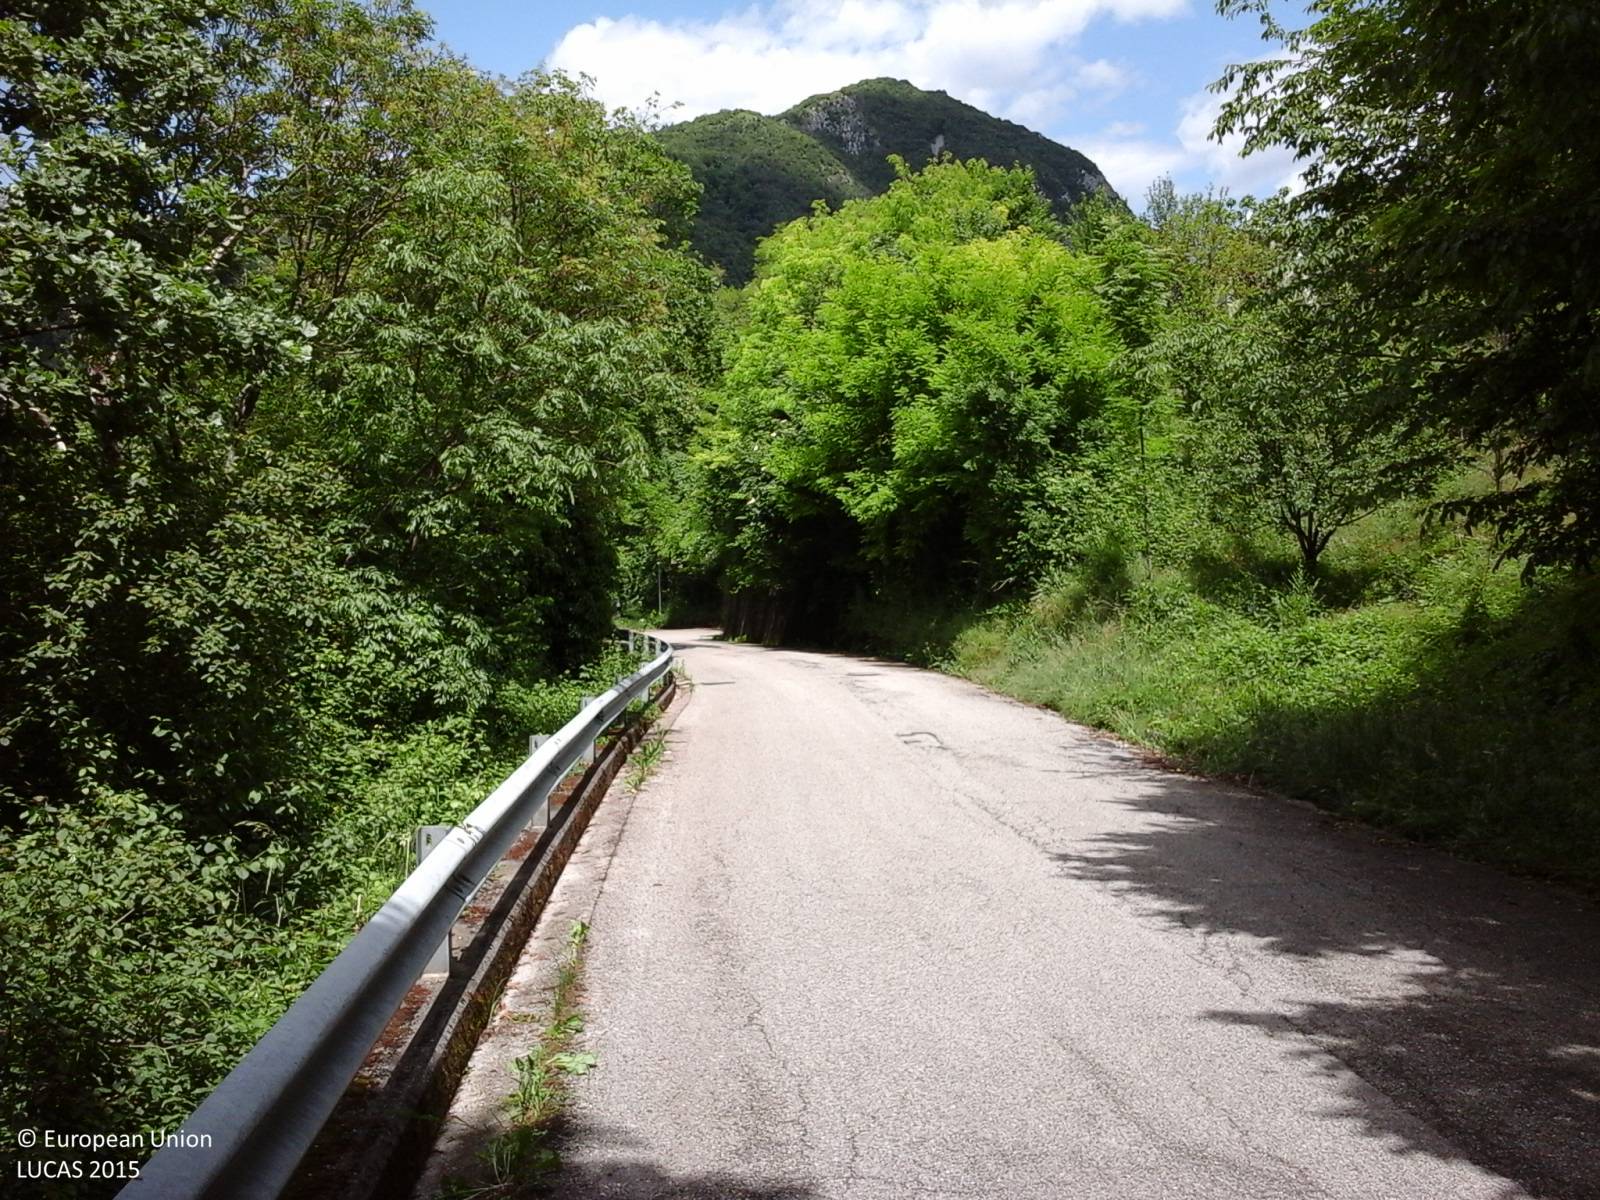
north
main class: Woodland
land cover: Broadleaved woodland
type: thermophilous deciduous forest
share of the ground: > 75 %
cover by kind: broadleaved forest trees 95 %, shrubs 5 %
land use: Forestry
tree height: > 5 m
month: May
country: IT
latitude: 46.2305
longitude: 13.2253
